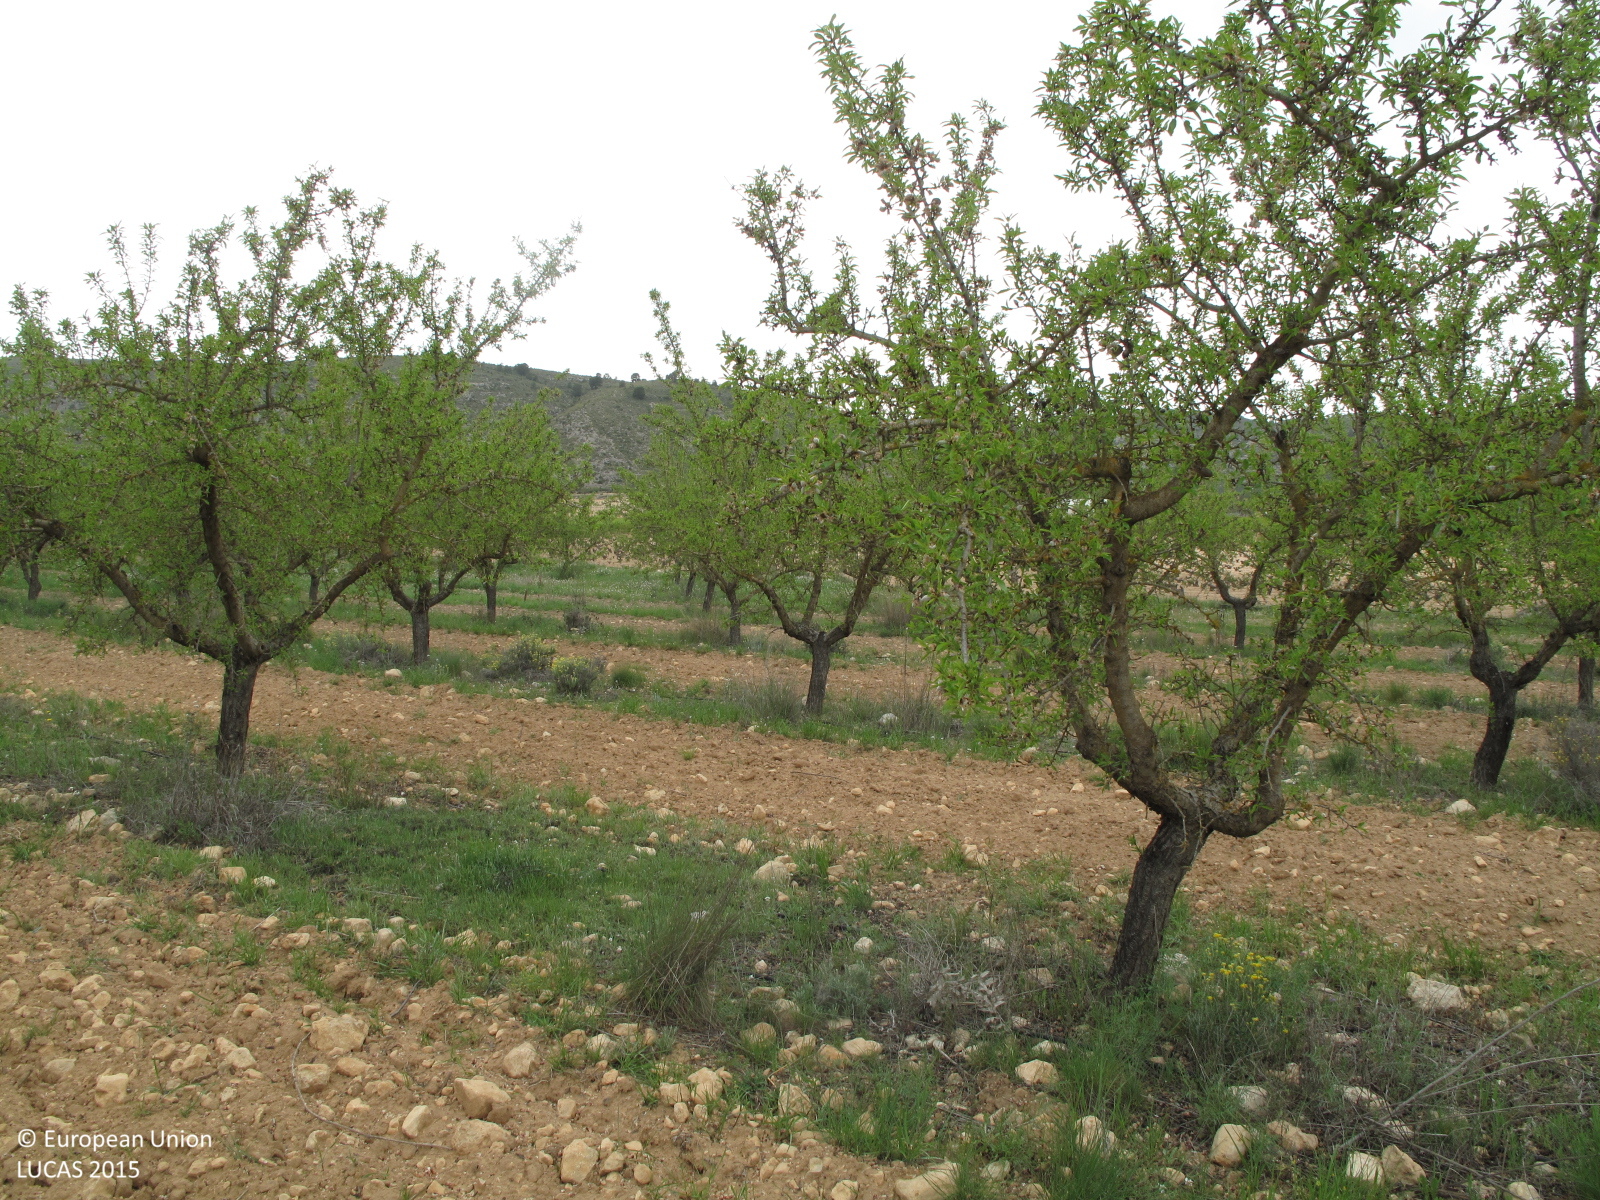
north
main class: Cropland
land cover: Nuts trees
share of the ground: 50 - 75 %
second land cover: Grassland without tree/shrub cover
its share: 25 - 50 %
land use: Agriculture (excluding fallow land and kitchen gardens)
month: April
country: ES
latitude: 38.5752
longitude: -0.9518
